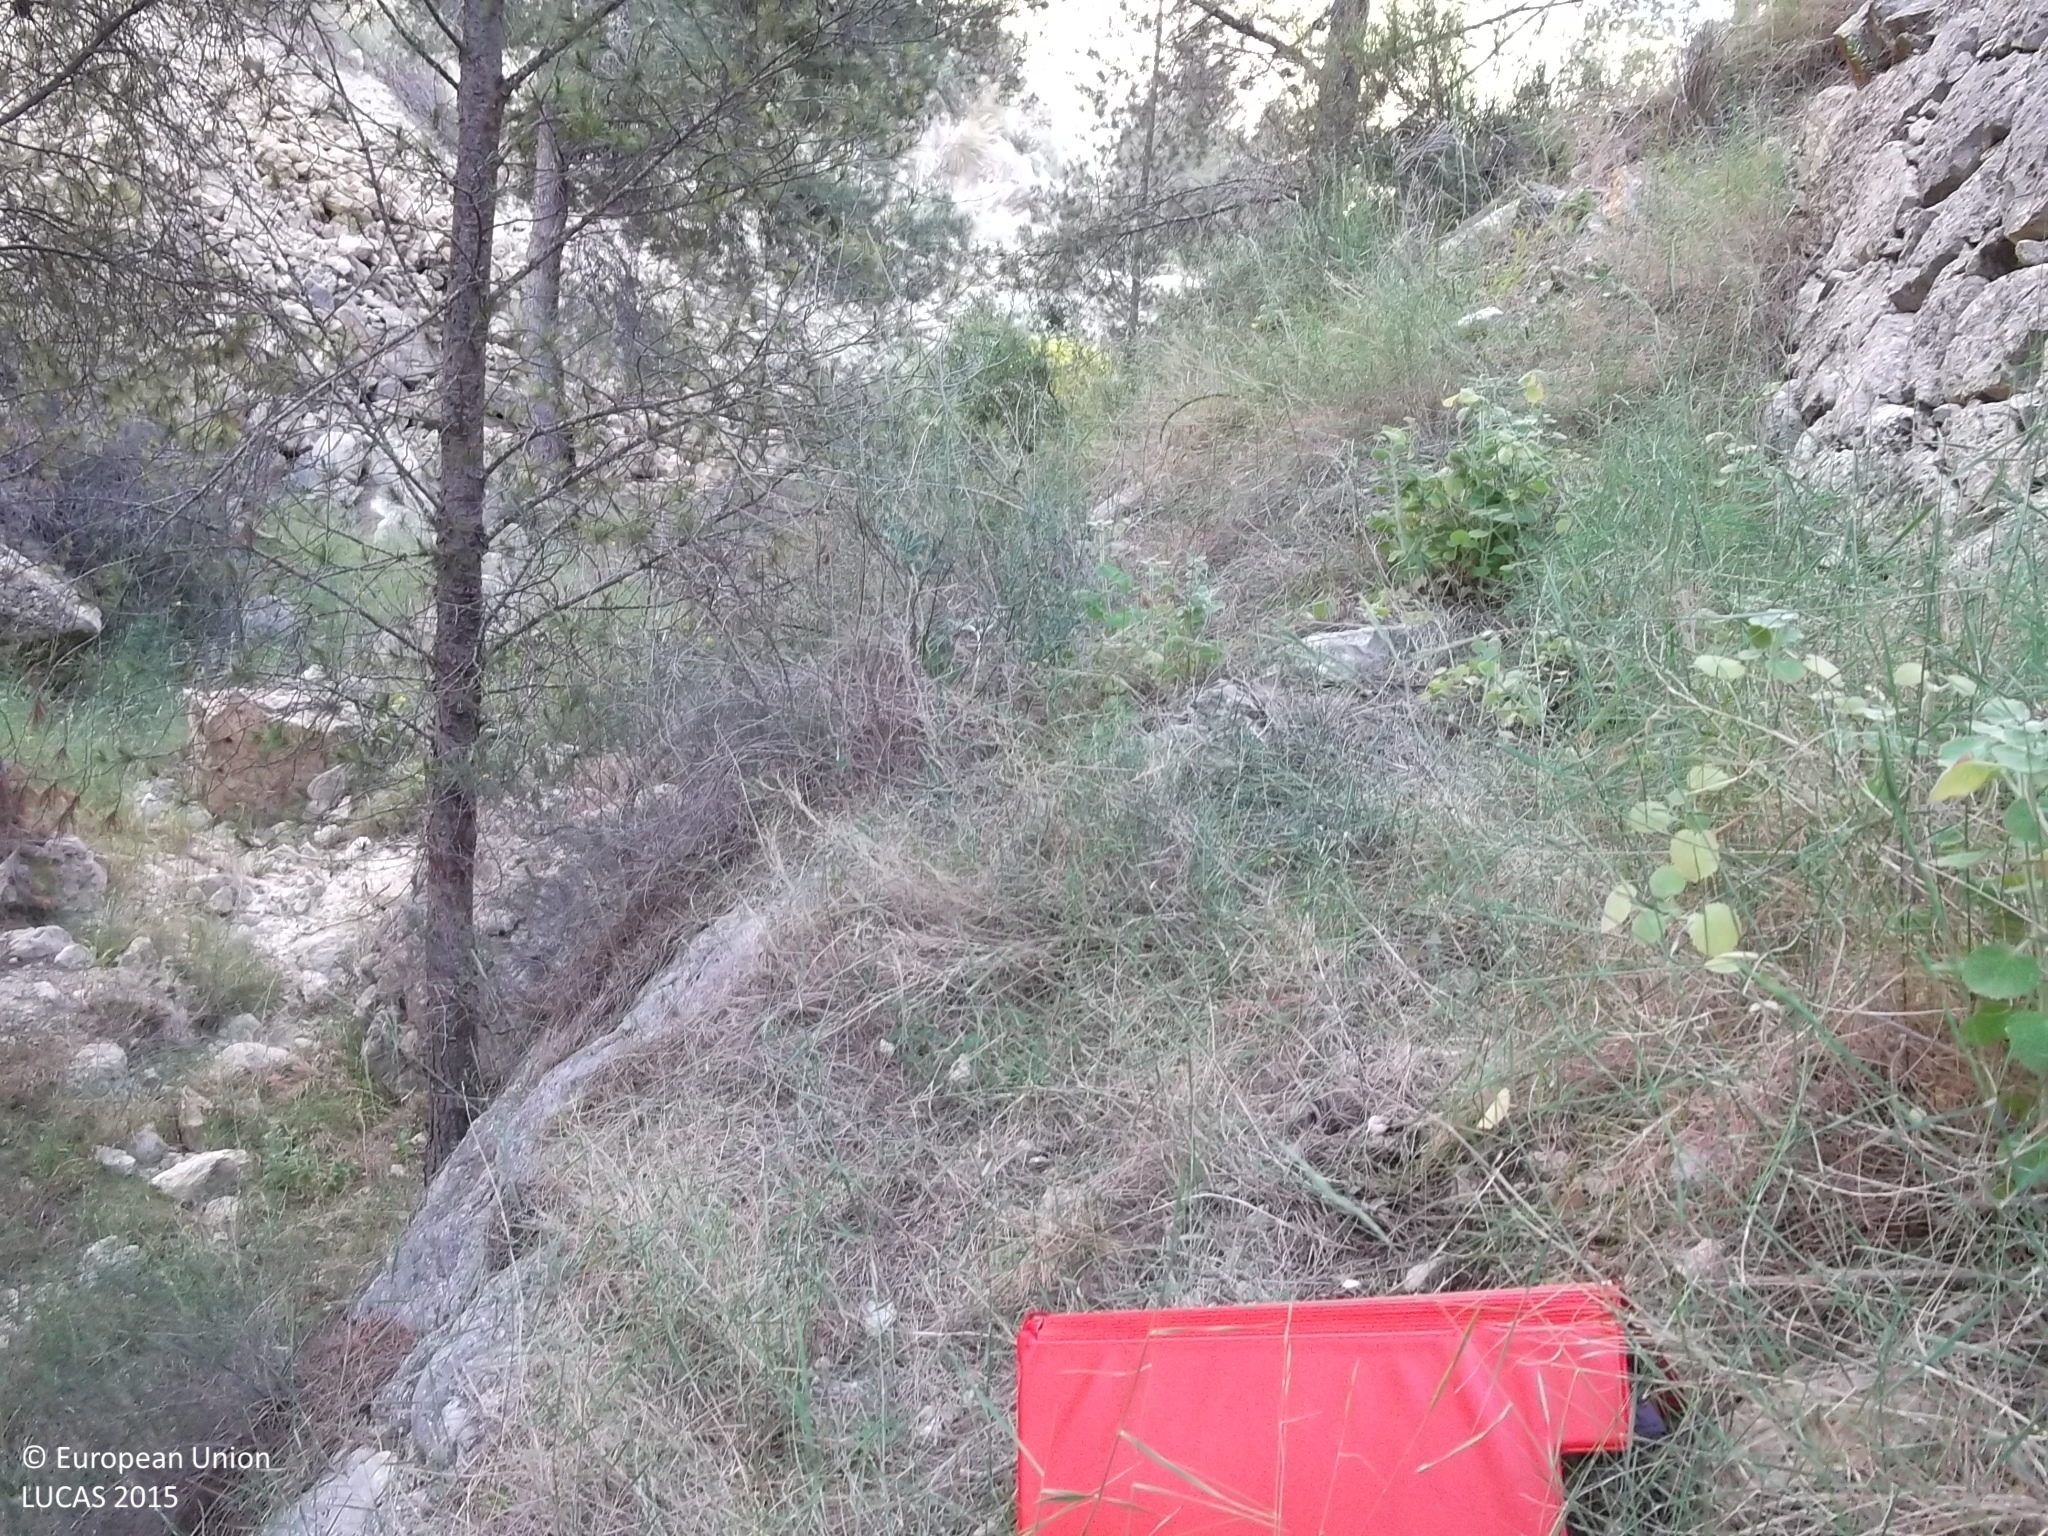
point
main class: Woodland
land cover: Pine dominated coniferous woodland
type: coniferous forest of the mediterranean region
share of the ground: 25 - 50 %
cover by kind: herbaceous plants 50 %, coniferous forest trees 25 %, shrubs 25 %
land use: Semi-natural and natural areas not in use
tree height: > 5 m
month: April
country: ES
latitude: 38.1487
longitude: -1.3179
